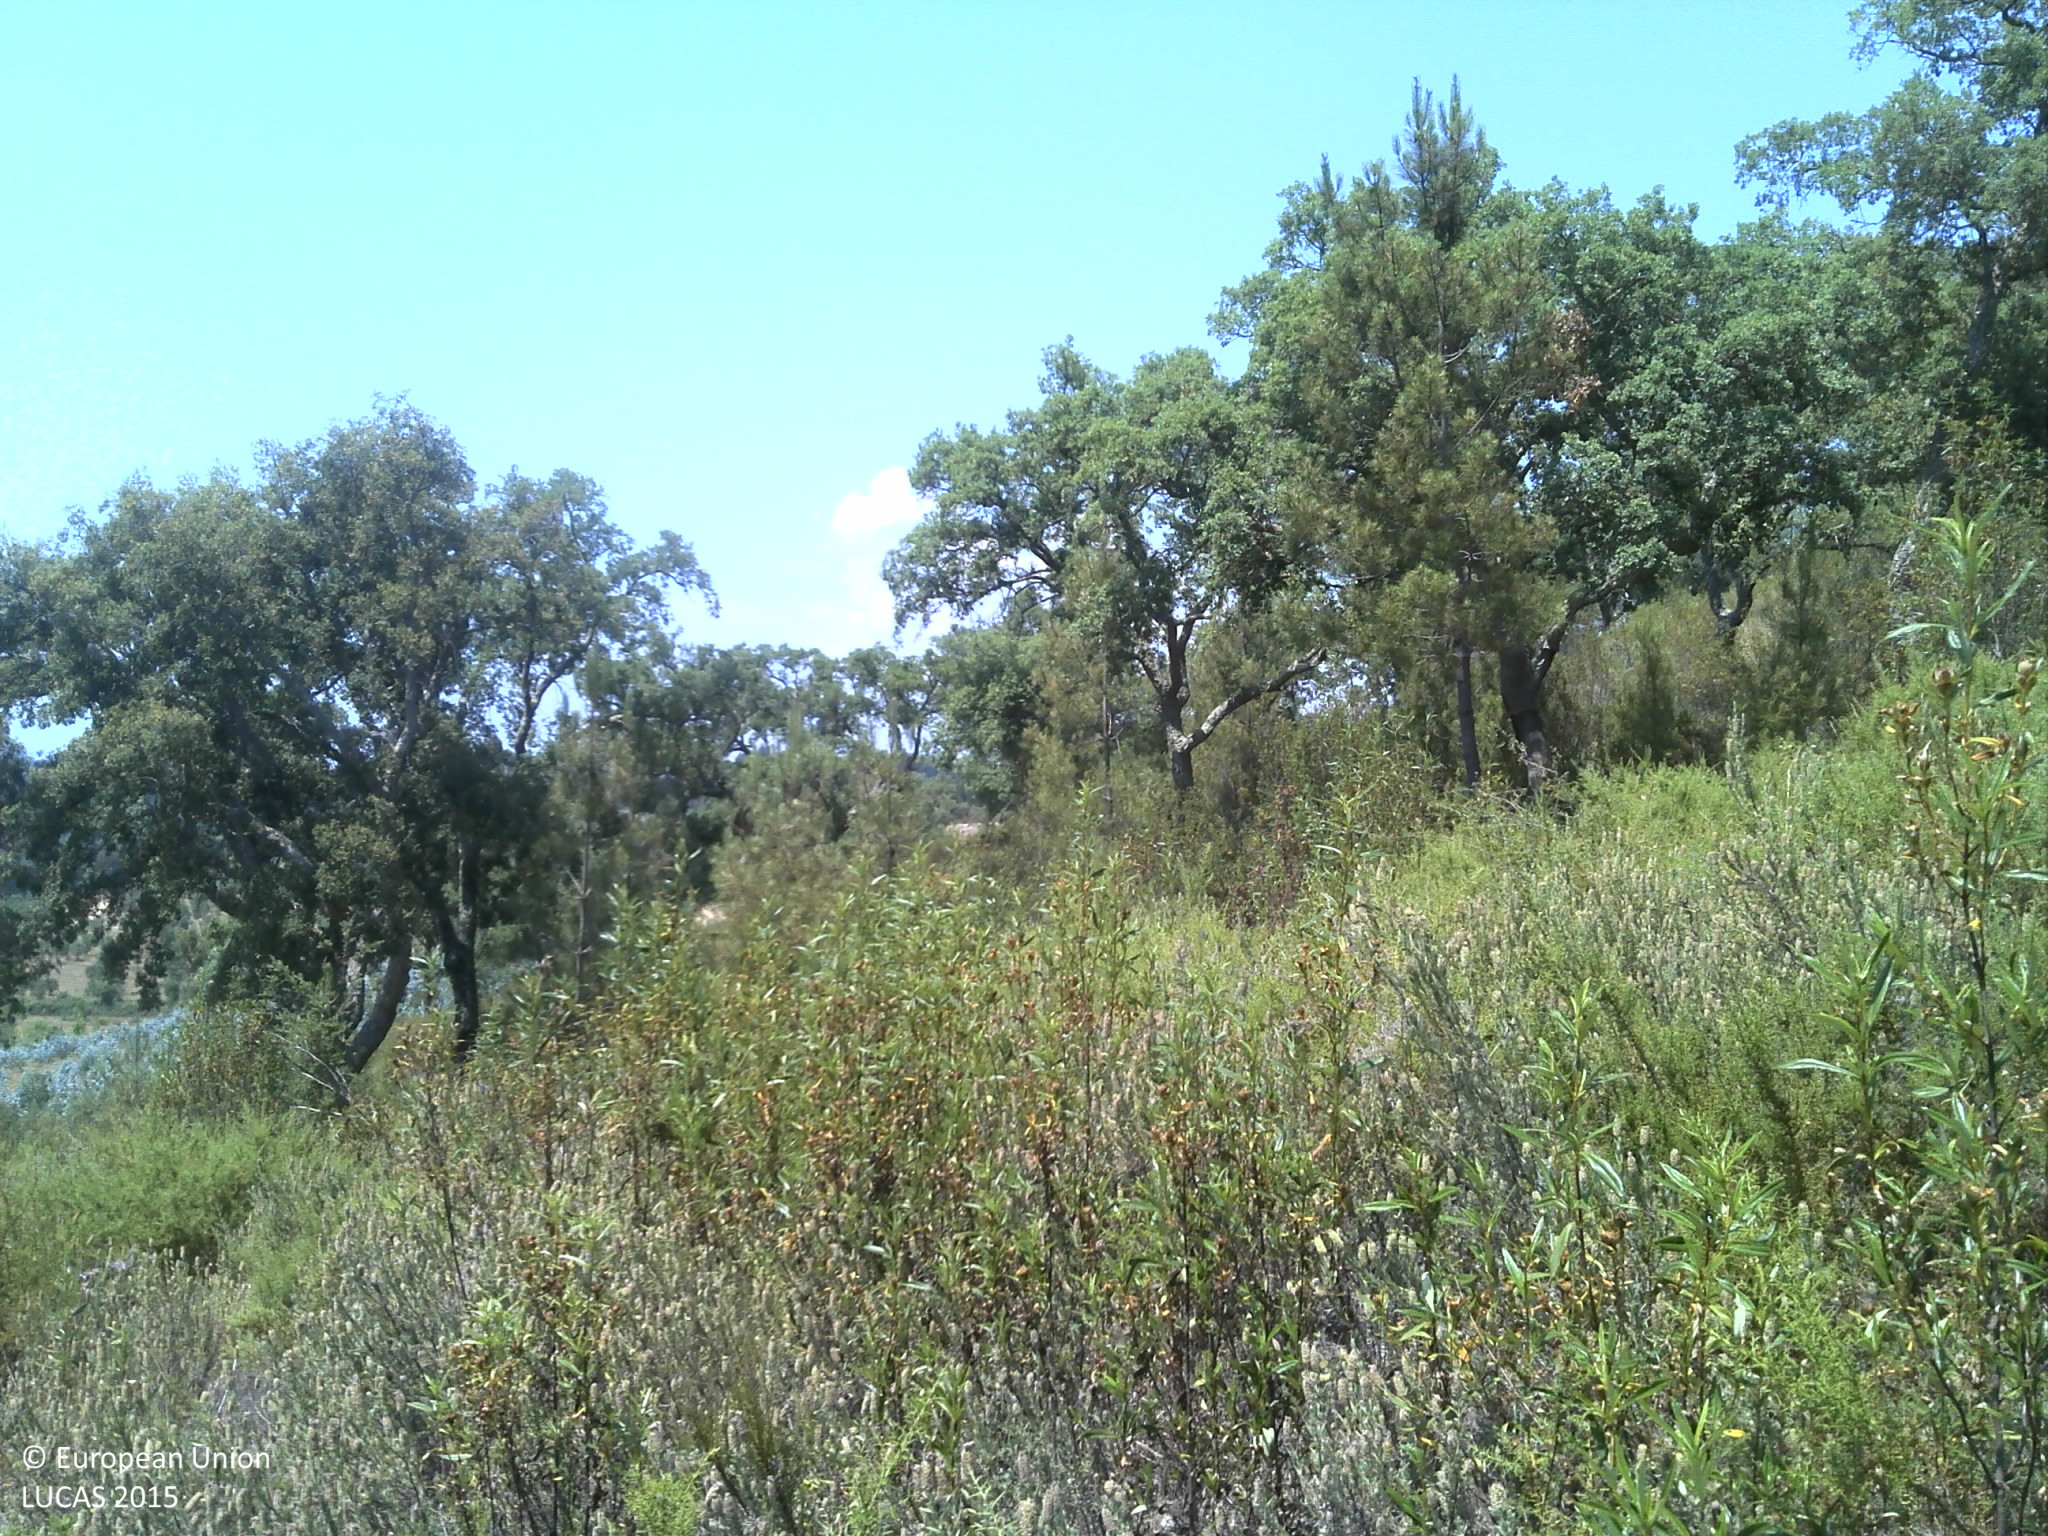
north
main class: Woodland
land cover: Broadleaved woodland
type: broadleaved evergreen forest
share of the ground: 10 - 25 %
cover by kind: shrubs 50 %, broadleaved forest trees 25 %, unconsolidated bare surface 15 %, herbaceous plants 10 %
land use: Forestry
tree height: > 5 m
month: June
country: PT
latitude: 39.4095
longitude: -8.0488
